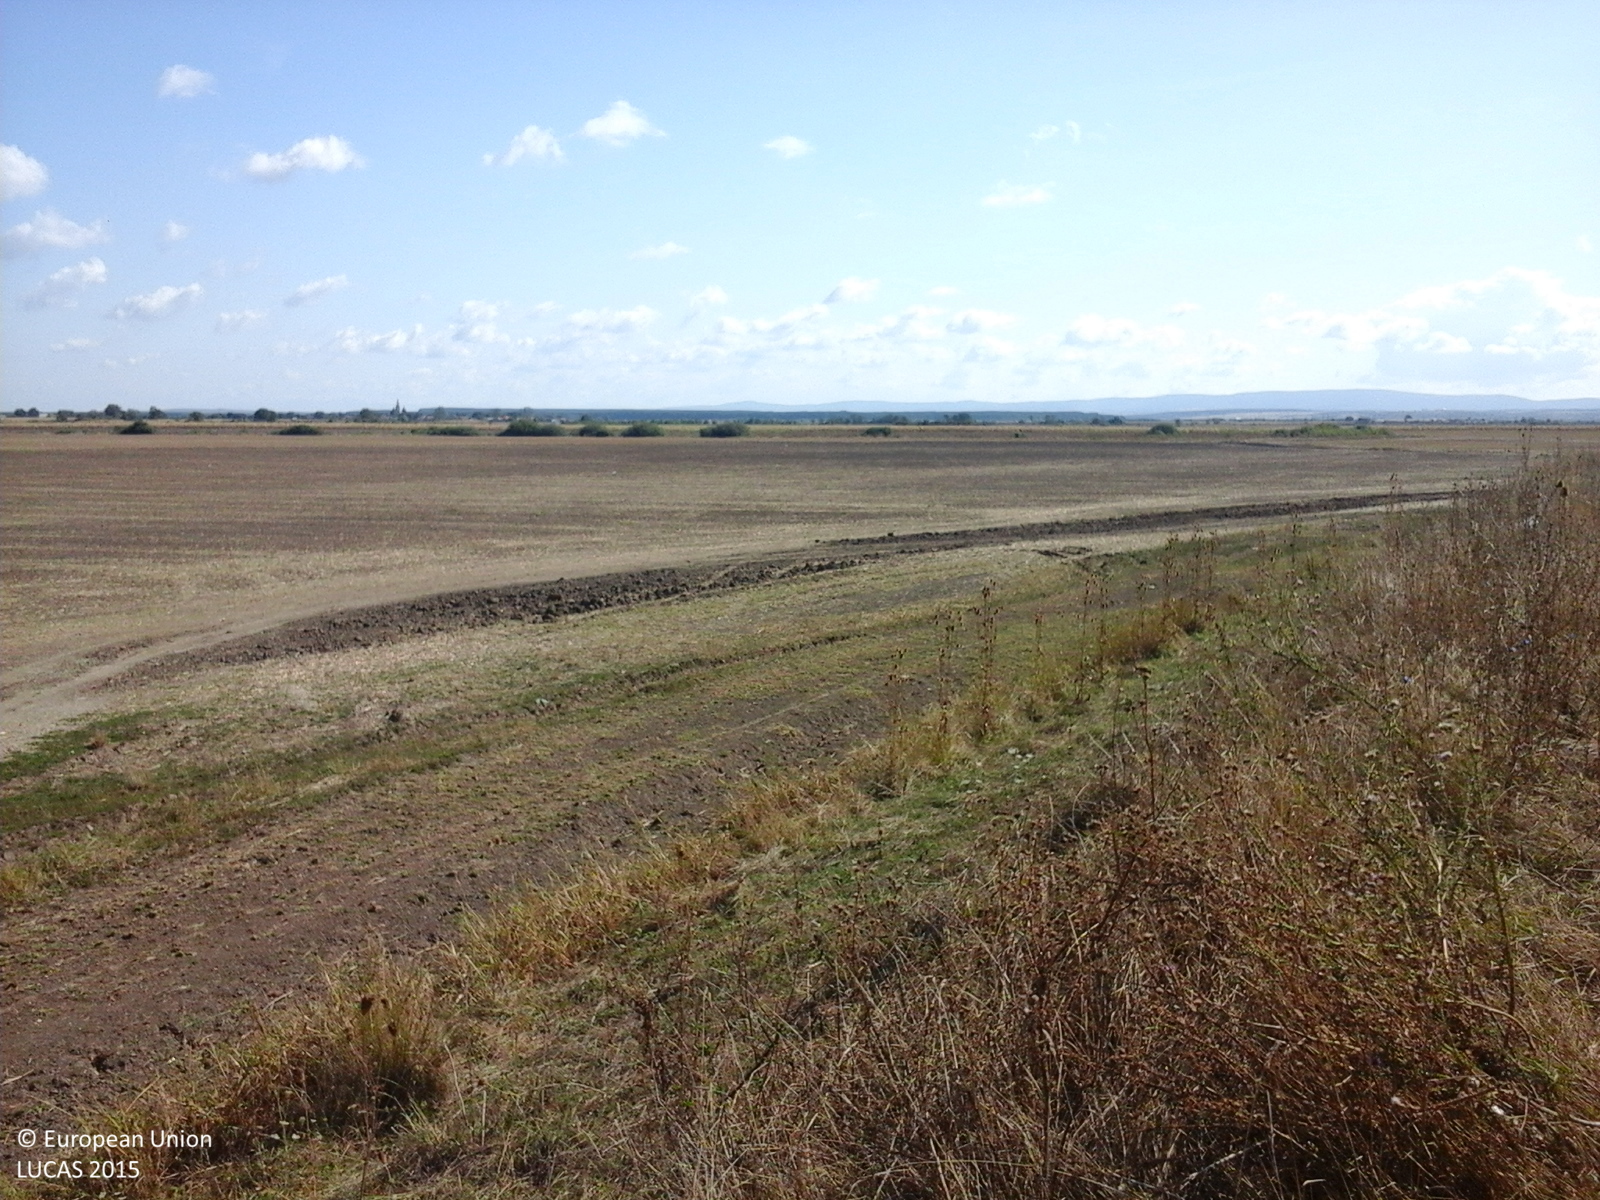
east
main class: Grassland
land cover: Grassland without tree/shrub cover
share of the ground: > 75 %
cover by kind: herbaceous plants 100 %
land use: Agriculture (excluding fallow land and kitchen gardens)
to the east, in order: Grassland without tree/shrub cover; Tracks; Other bare soil
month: September
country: RO
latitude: 47.5876
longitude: 22.7605
